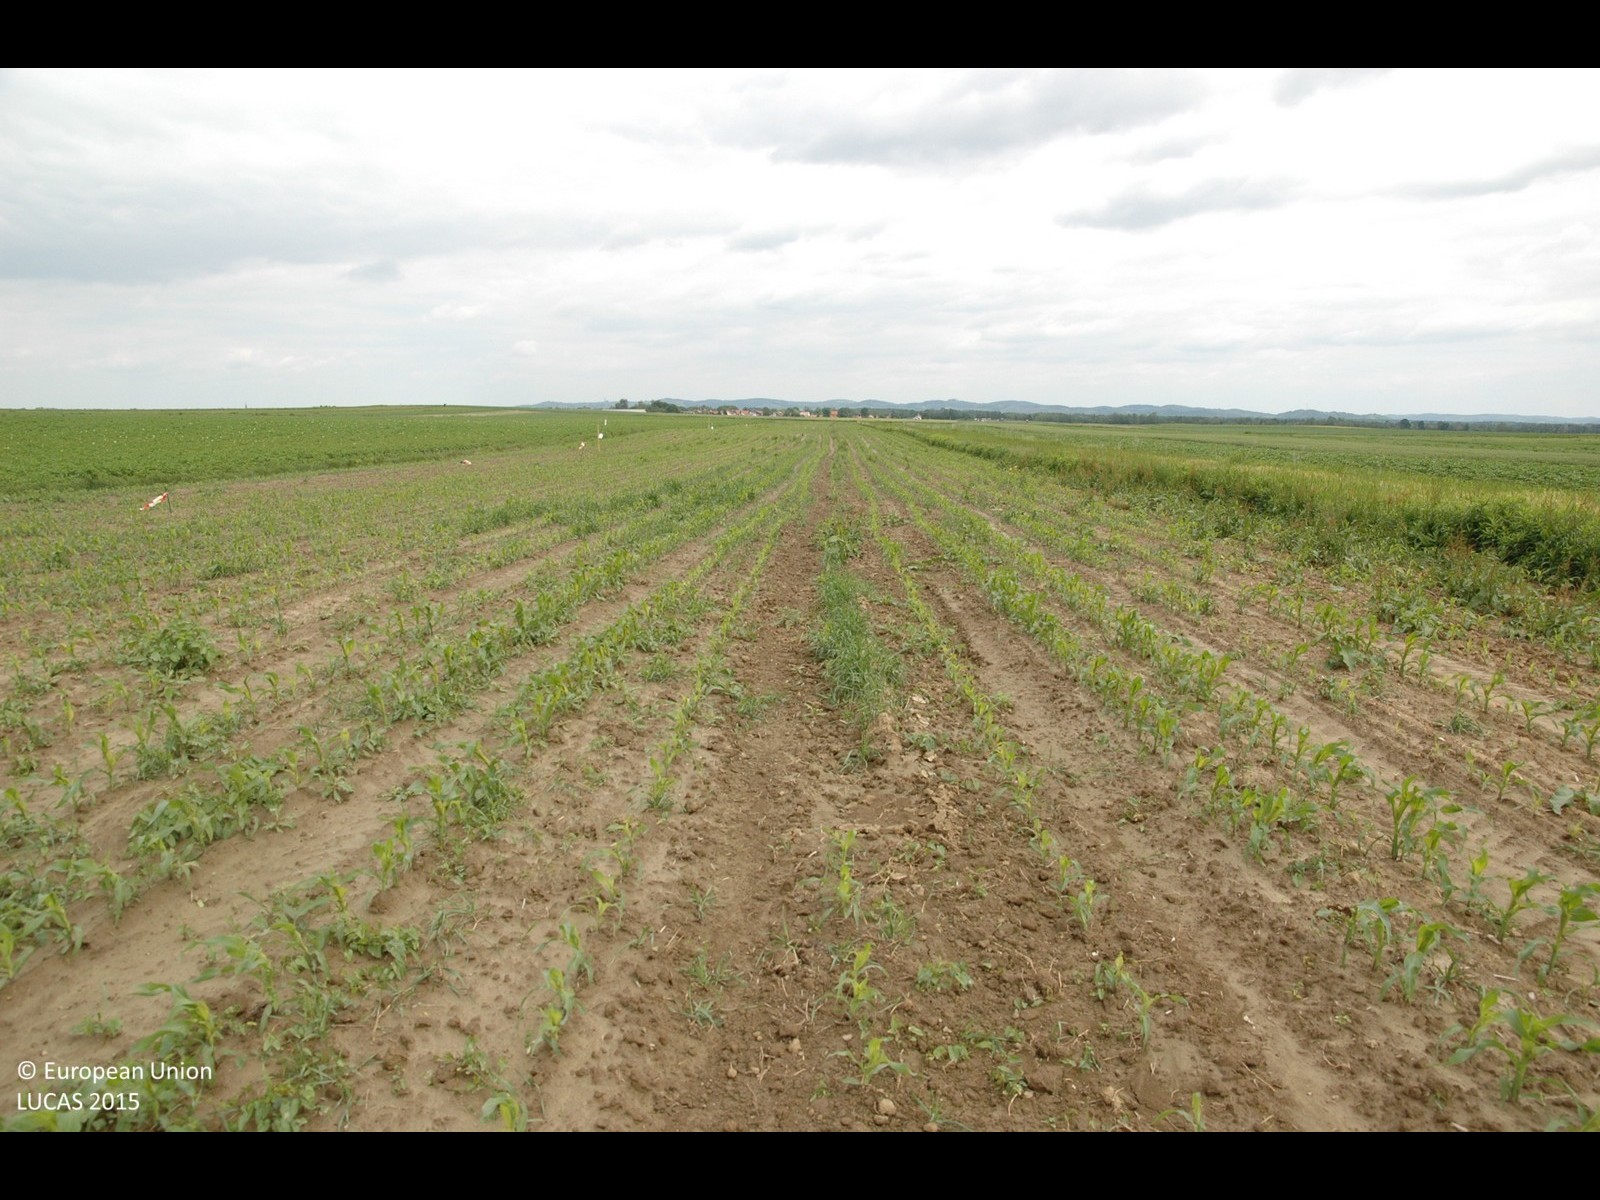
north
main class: Cropland
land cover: Maize
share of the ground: 10 - 25 %
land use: Agriculture (excluding fallow land and kitchen gardens)
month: May
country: HR
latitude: 46.4443
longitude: 16.4703
